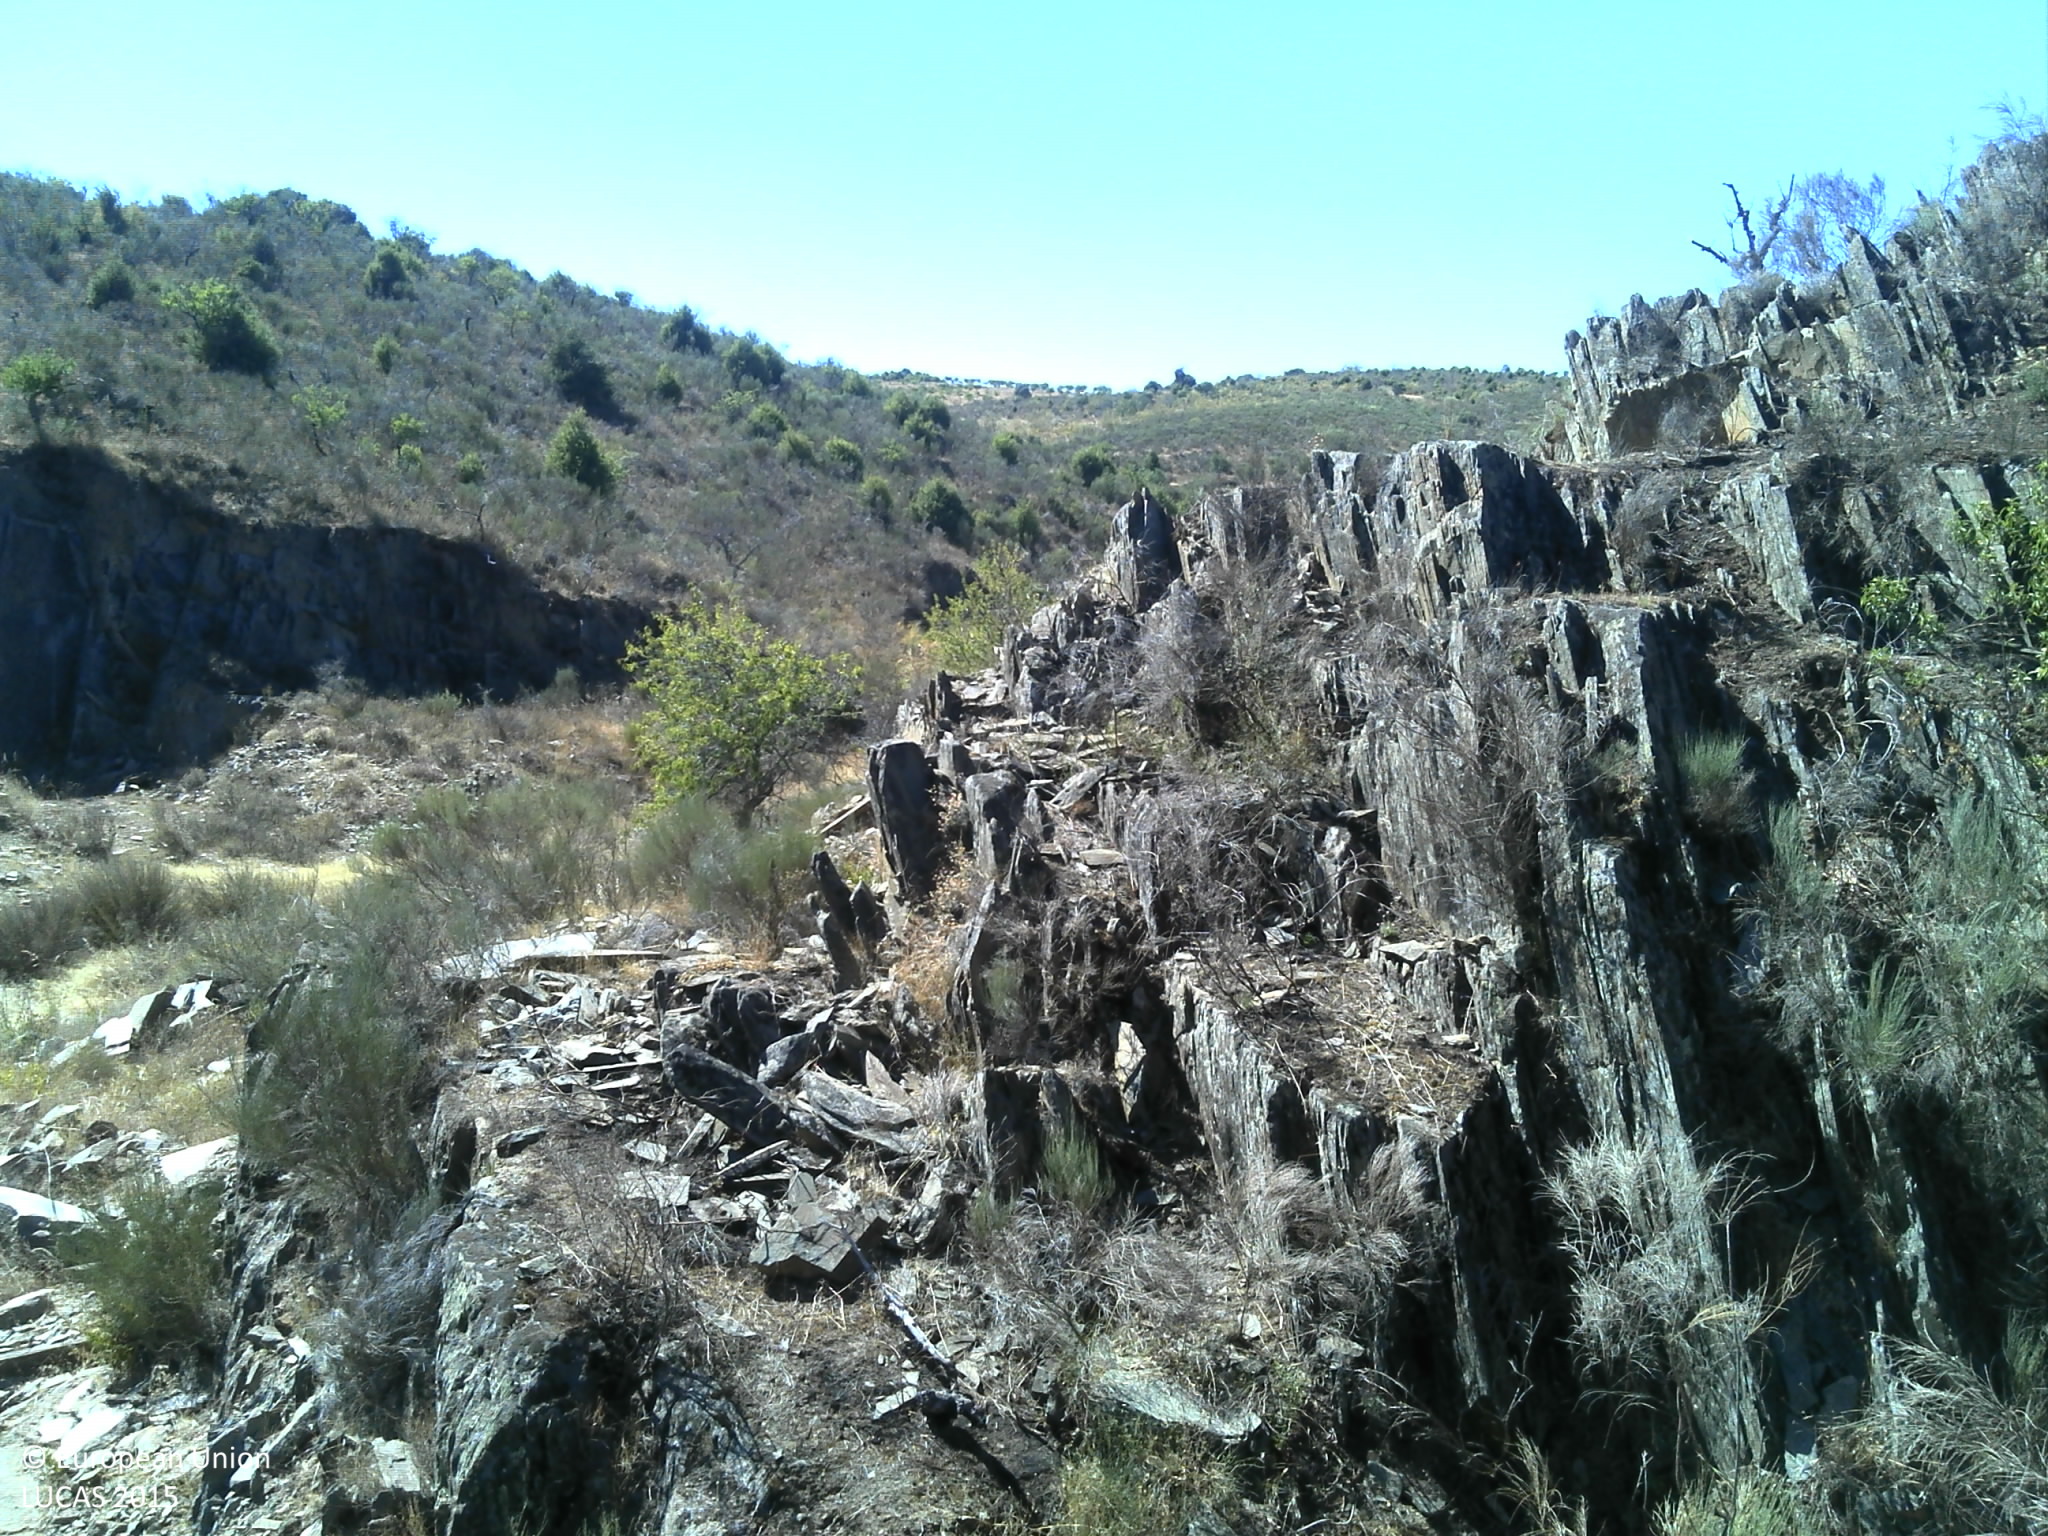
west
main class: Shrubland
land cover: Shrubland without tree cover
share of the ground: 50 - 75 %
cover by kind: shrubs 70 %, herbaceous plants 15 %, consolidated bare surface 10 %, unconsolidated bare surface 5 %
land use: Semi-natural and natural areas not in use
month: July
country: PT
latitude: 41.2909
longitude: -7.0328
